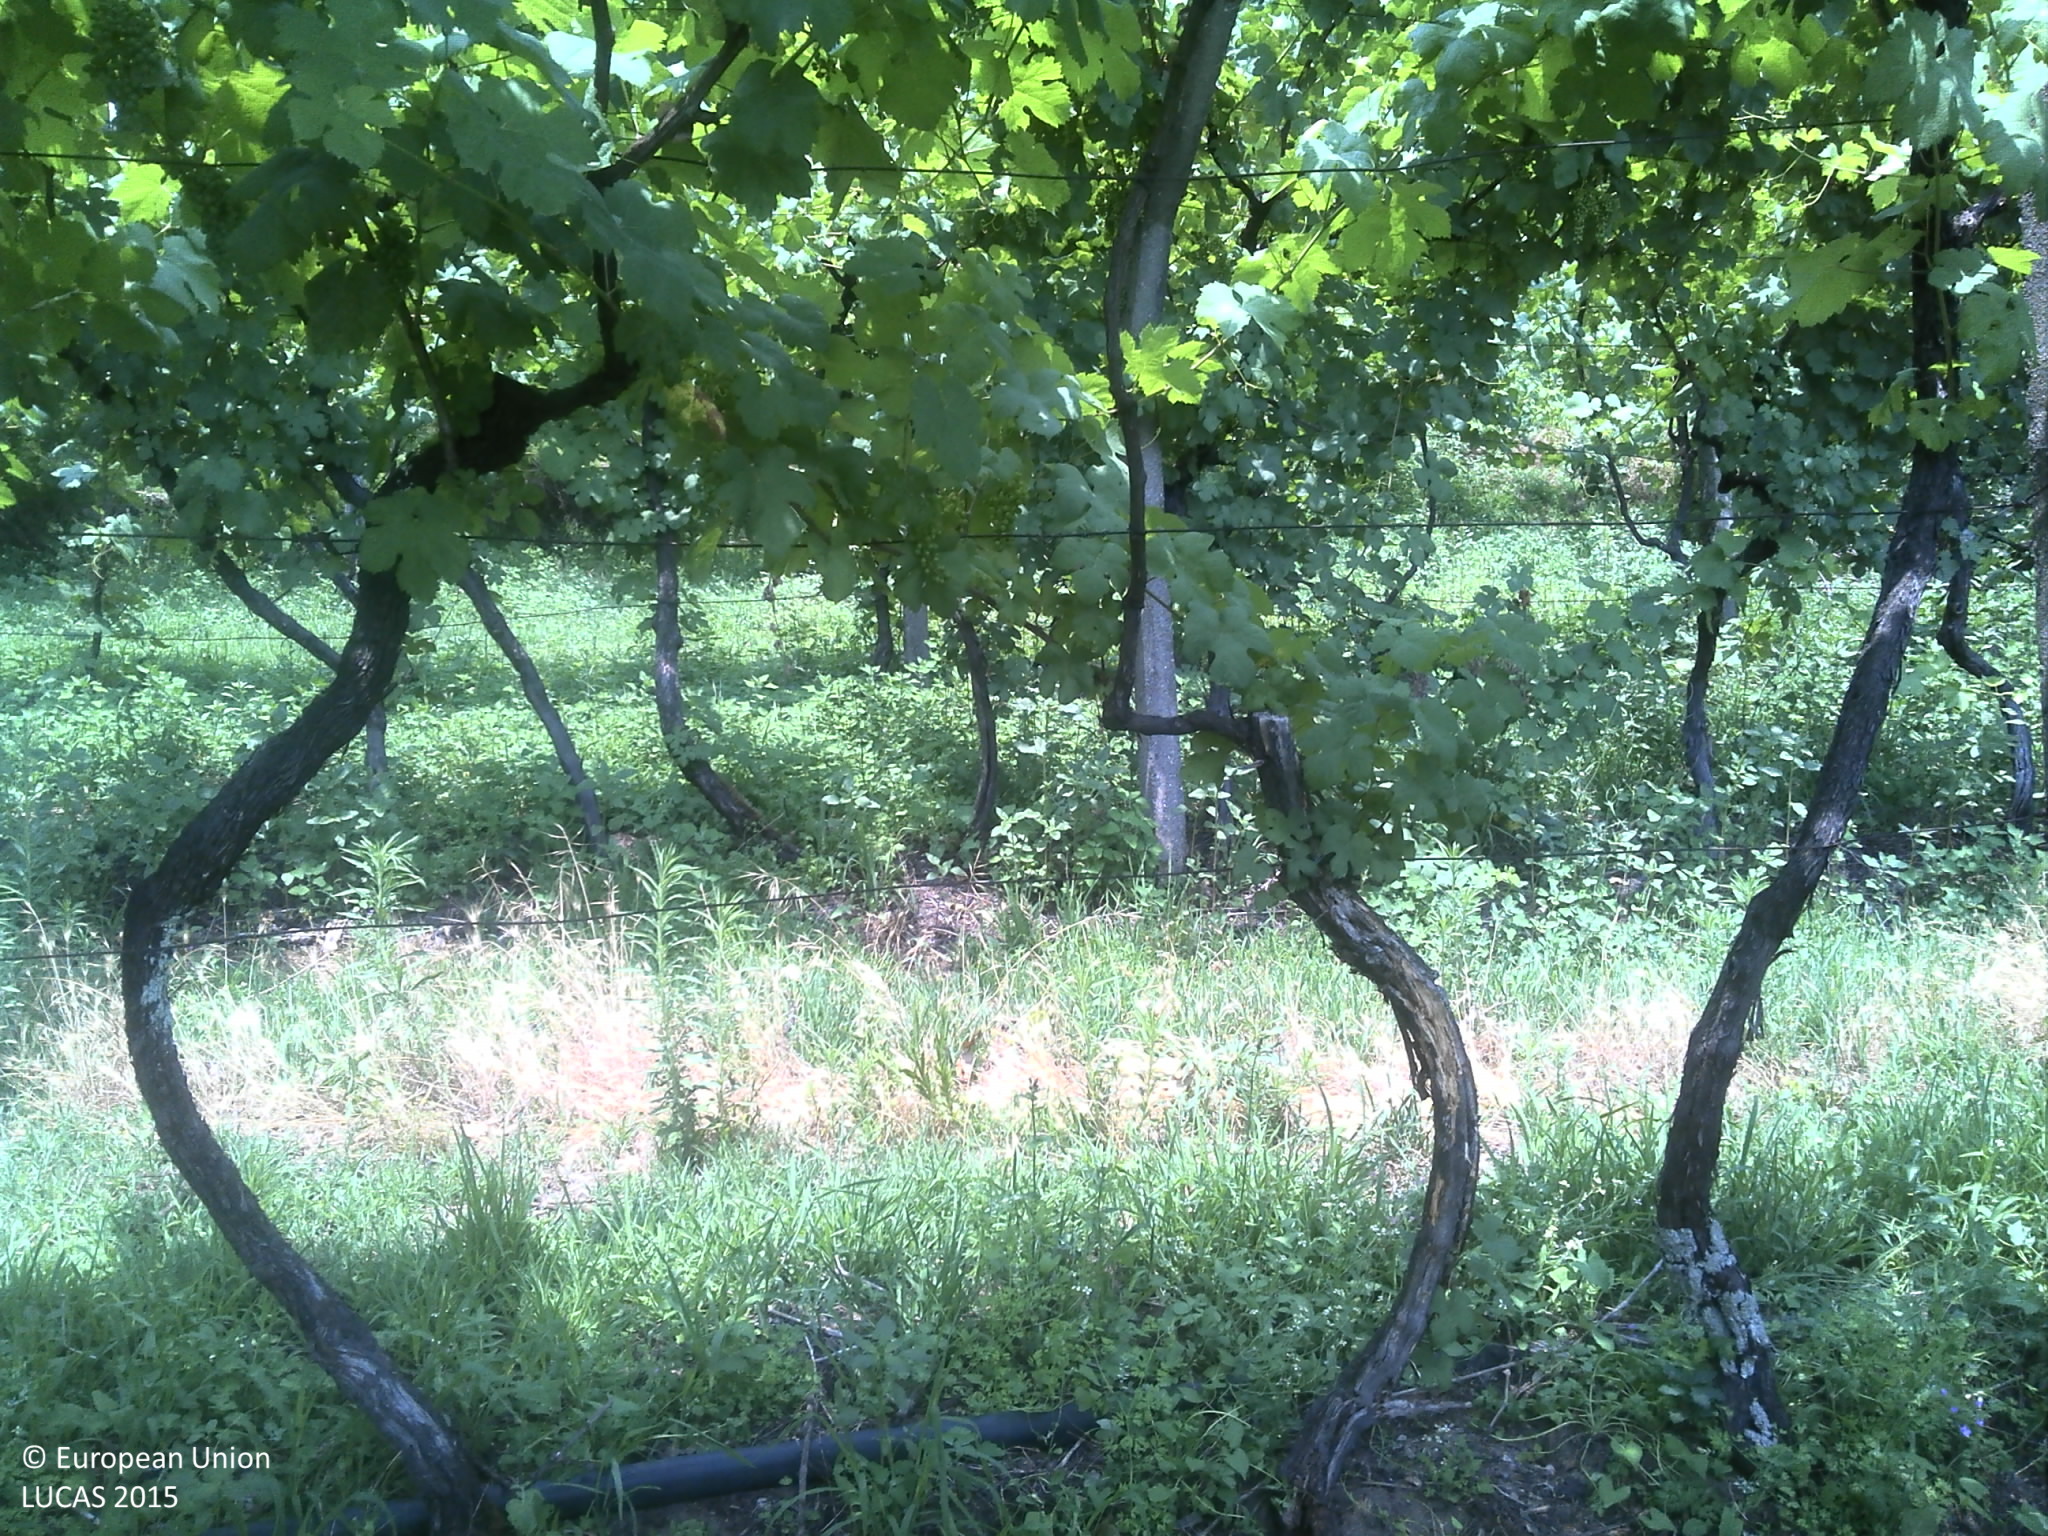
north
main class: Cropland
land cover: Vineyards
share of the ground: 25 - 50 %
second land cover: Grassland without tree/shrub cover
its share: 50 - 75 %
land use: Agriculture (excluding fallow land and kitchen gardens)
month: June
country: PT
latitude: 41.3176
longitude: -8.2183
